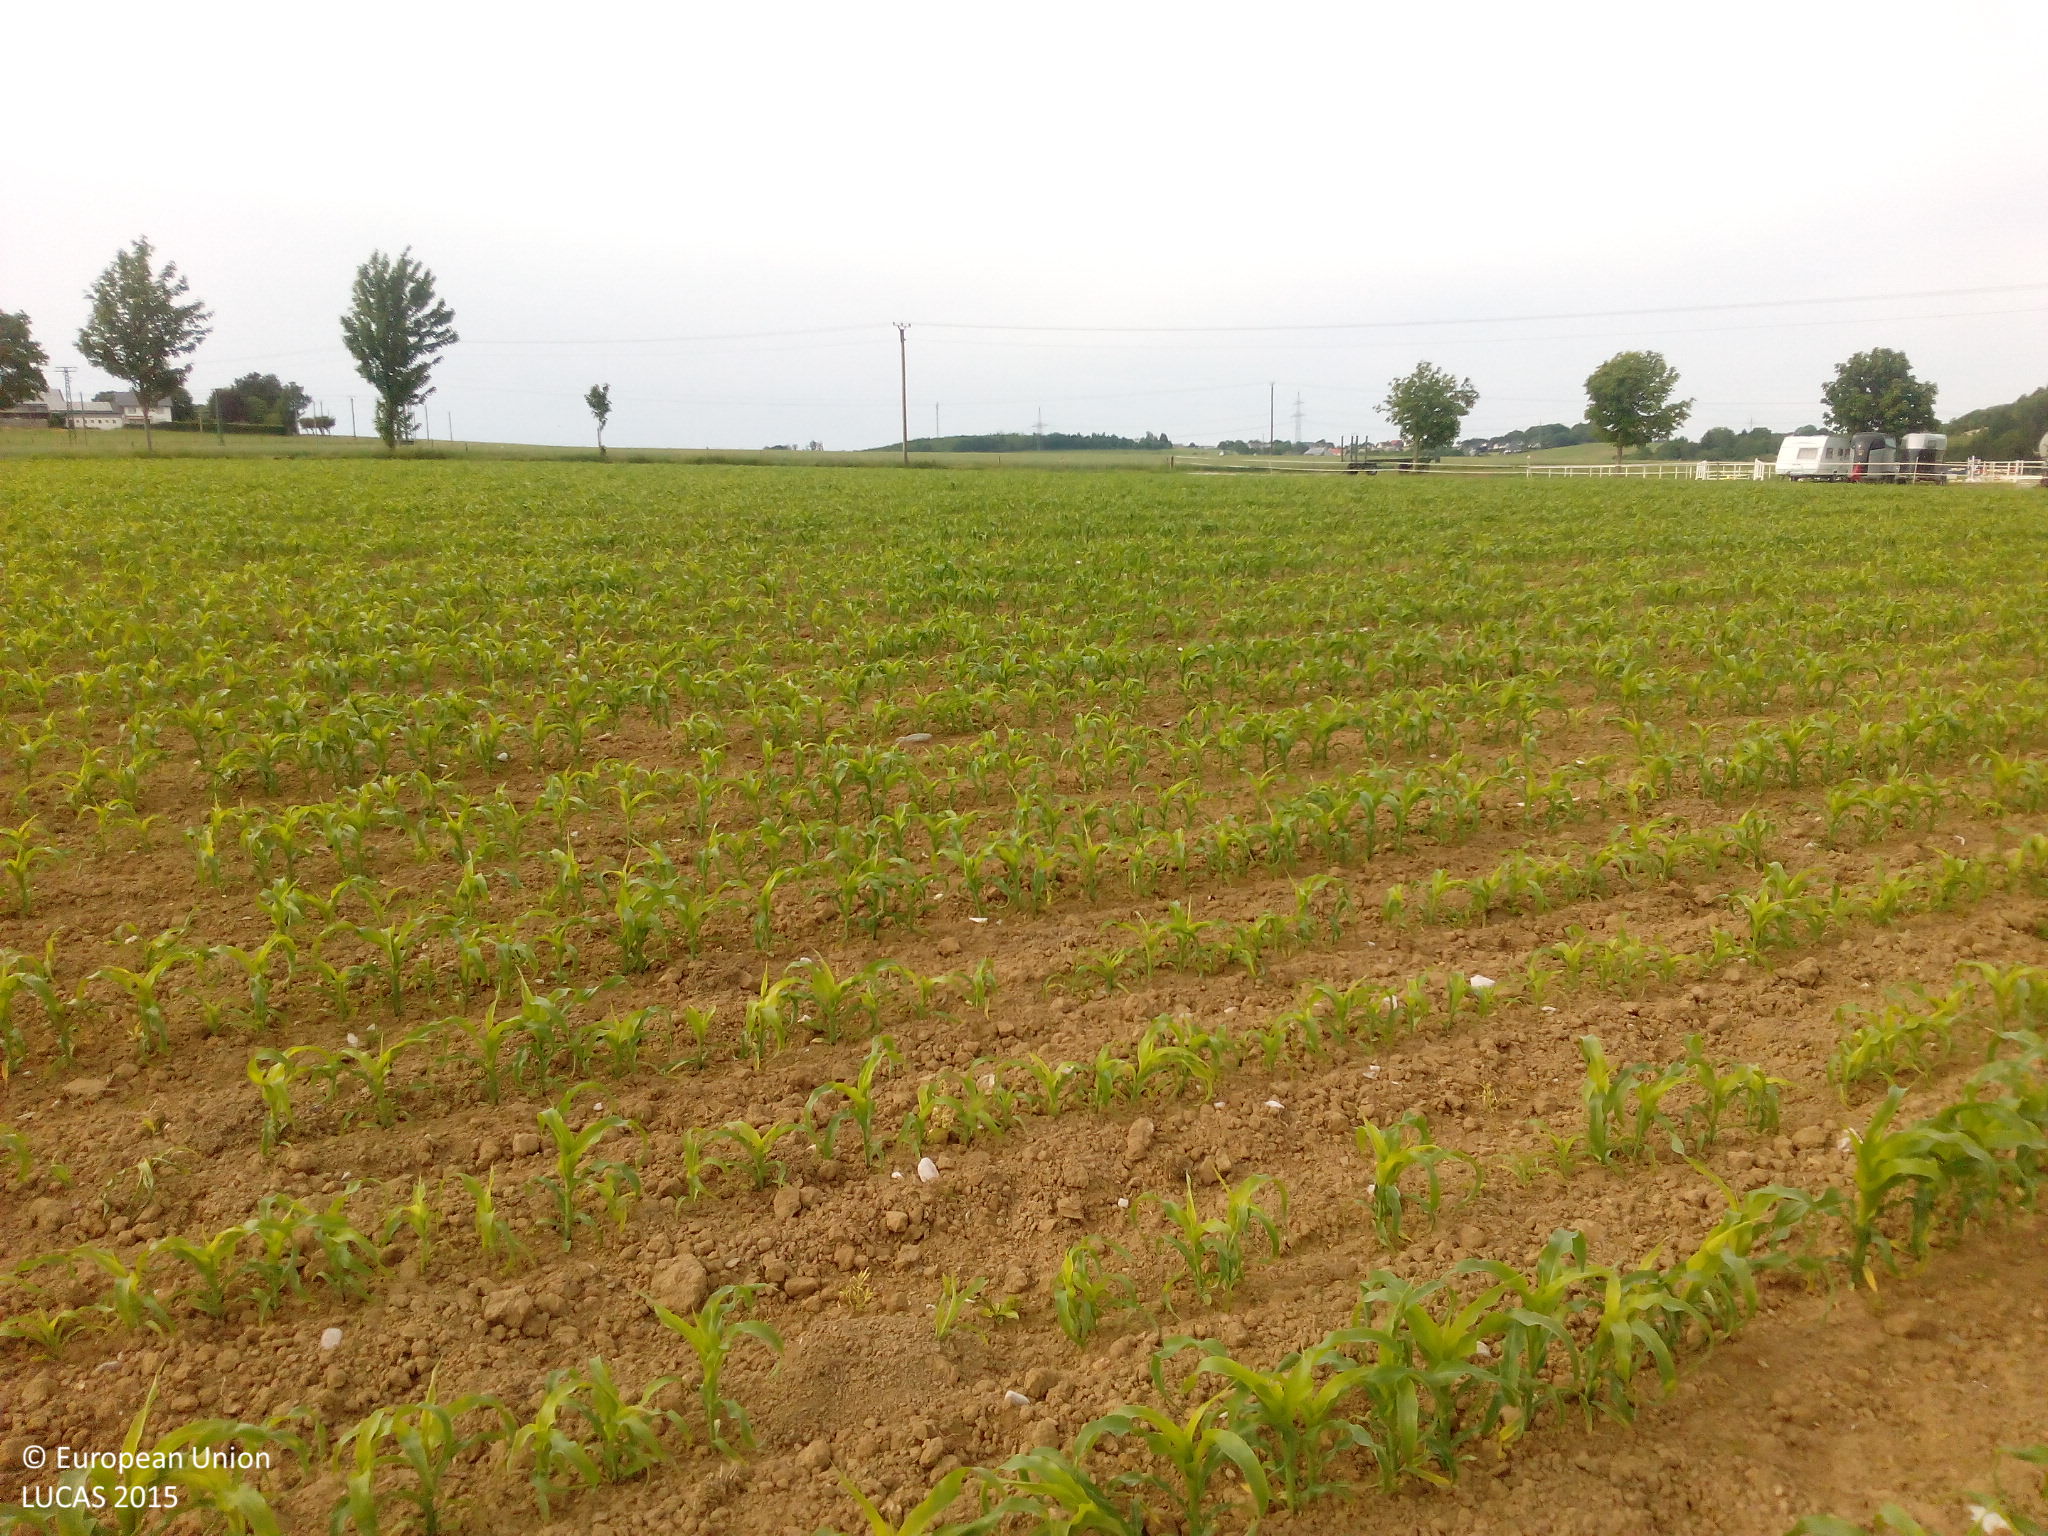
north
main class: Cropland
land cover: Maize
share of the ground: 25 - 50 %
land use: Agriculture (excluding fallow land and kitchen gardens)
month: June
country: DE
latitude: 51.4161
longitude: 8.5768
